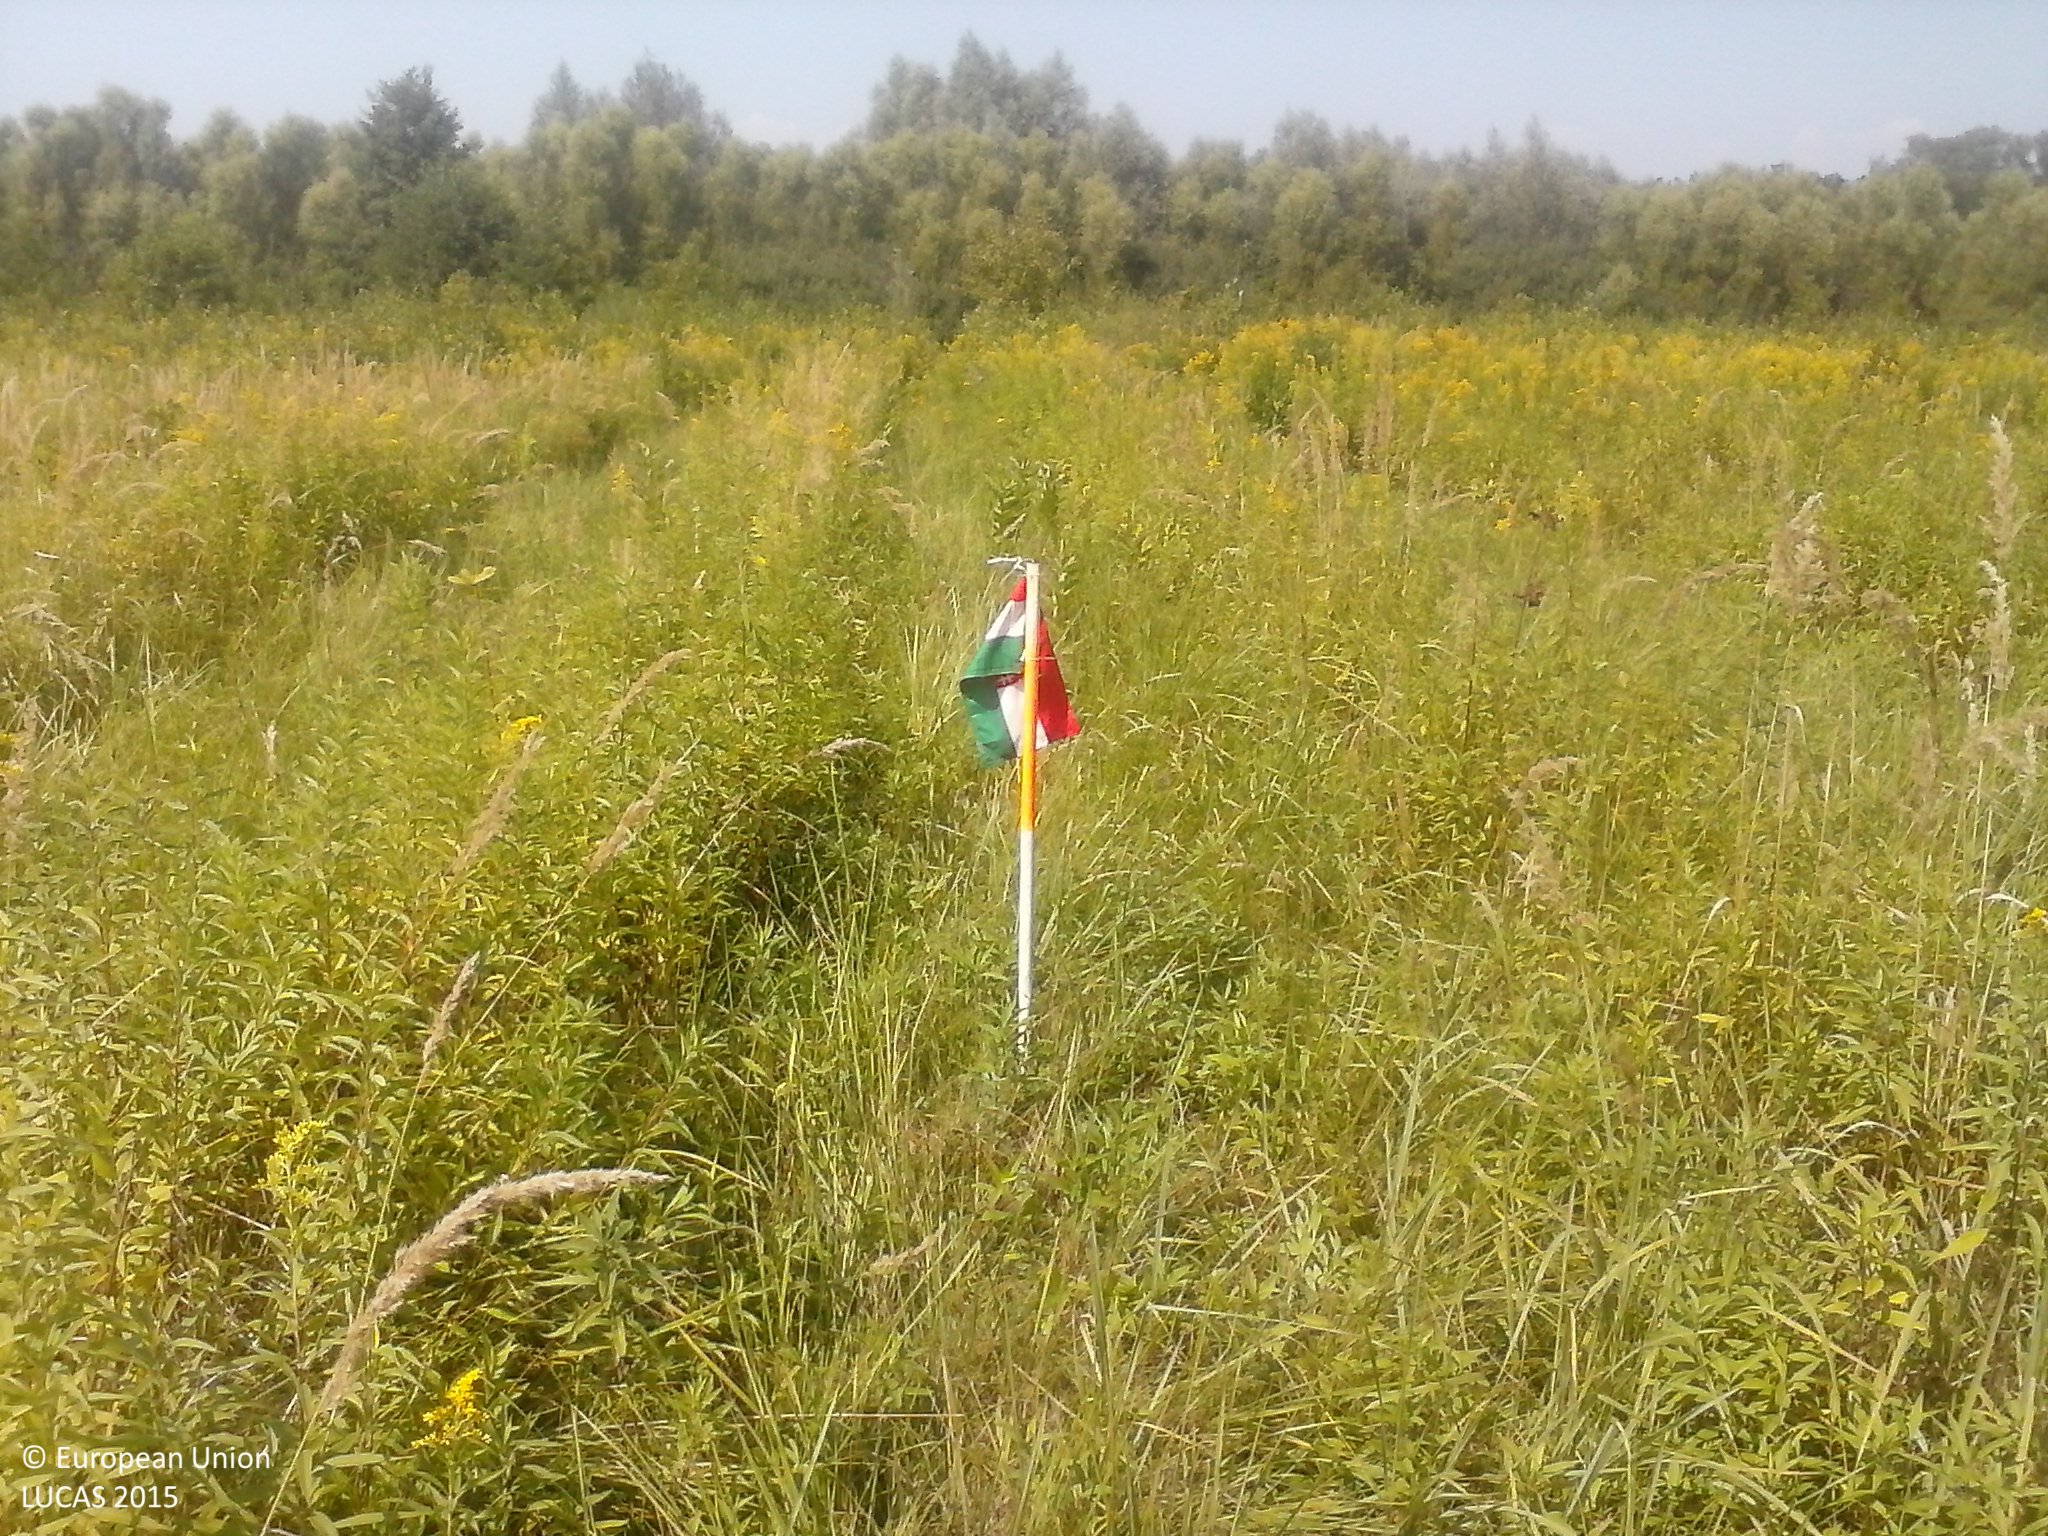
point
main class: Woodland
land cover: Broadleaved woodland
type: acidophilous oak and oak-birch forest
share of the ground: 10 - 25 %
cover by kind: herbaceous plants 80 %, broadleaved forest trees 10 %, shrubs 10 %
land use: Forestry
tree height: < 5 m
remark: Nursery
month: August
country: HU
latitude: 45.8021
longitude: 17.9433
